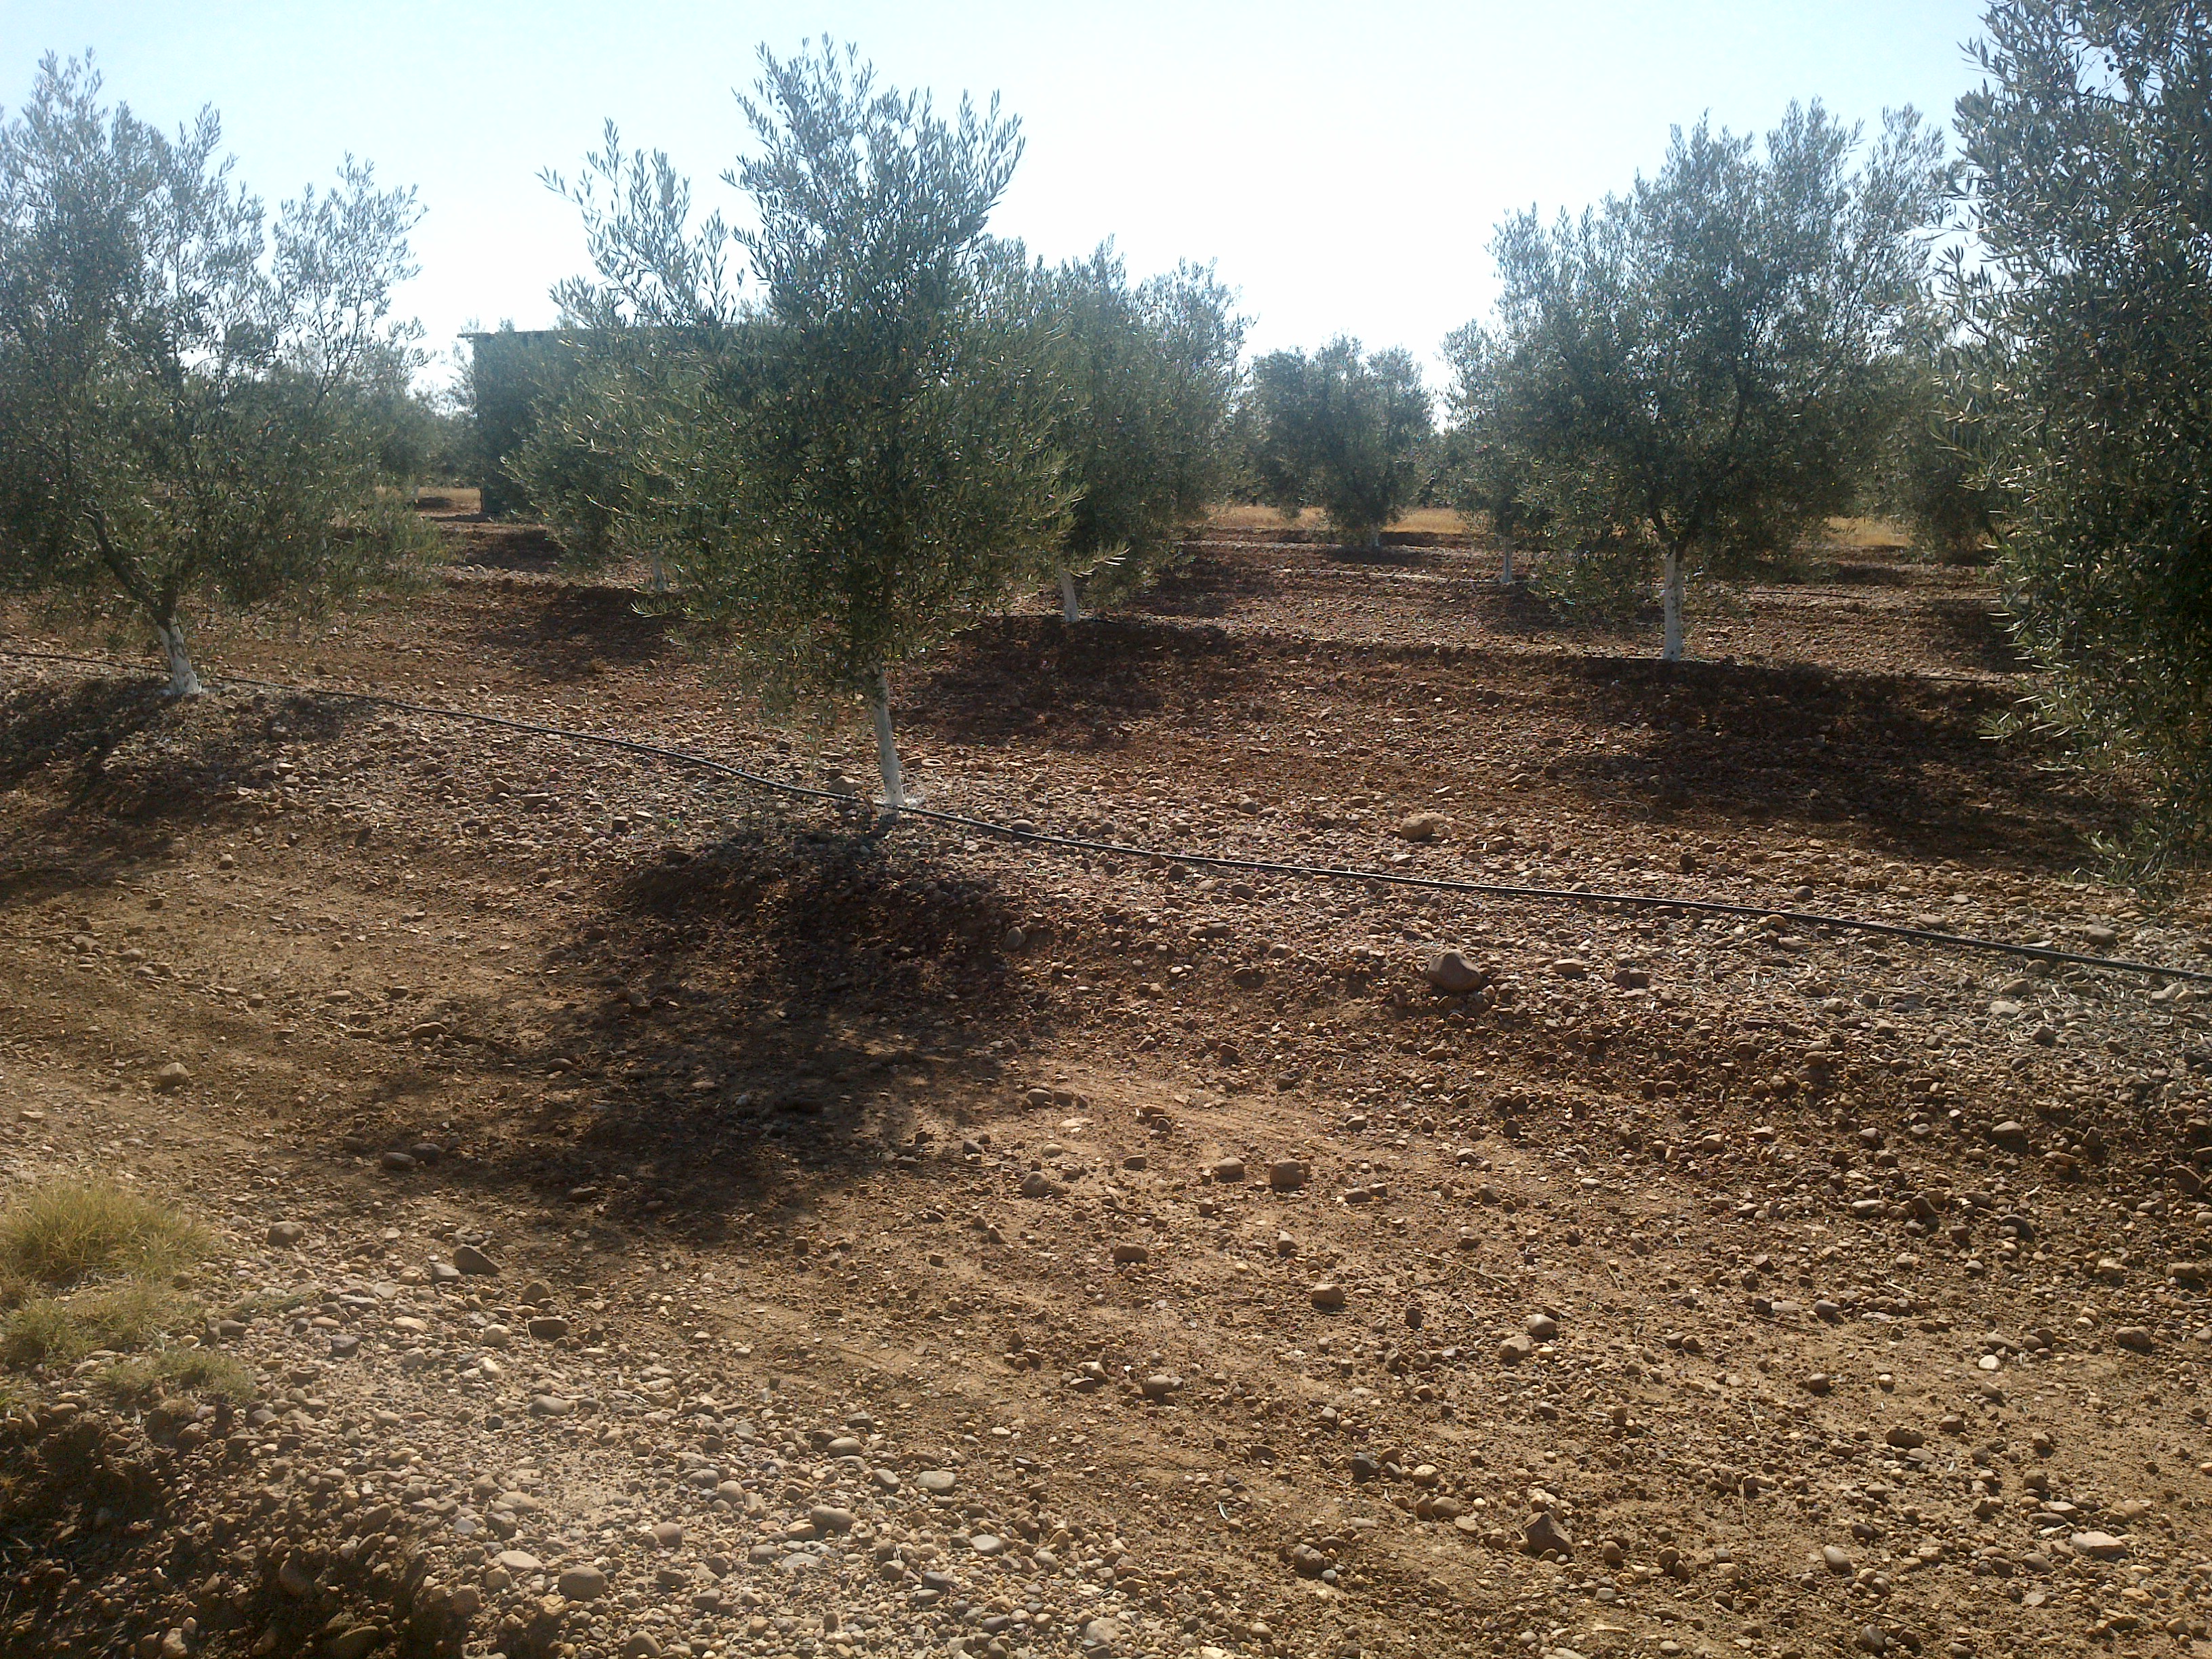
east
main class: Cropland
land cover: Olive groves
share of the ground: 25 - 50 %
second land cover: Other bare soil
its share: > 75 %
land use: Agriculture (excluding fallow land and kitchen gardens)
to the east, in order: Olive groves; Other bare soil; Grass margins; Olive groves; Durum wheat; Olive groves; Single bushes/trees; Olive groves
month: June
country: ES
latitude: 37.7170
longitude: -4.9546
